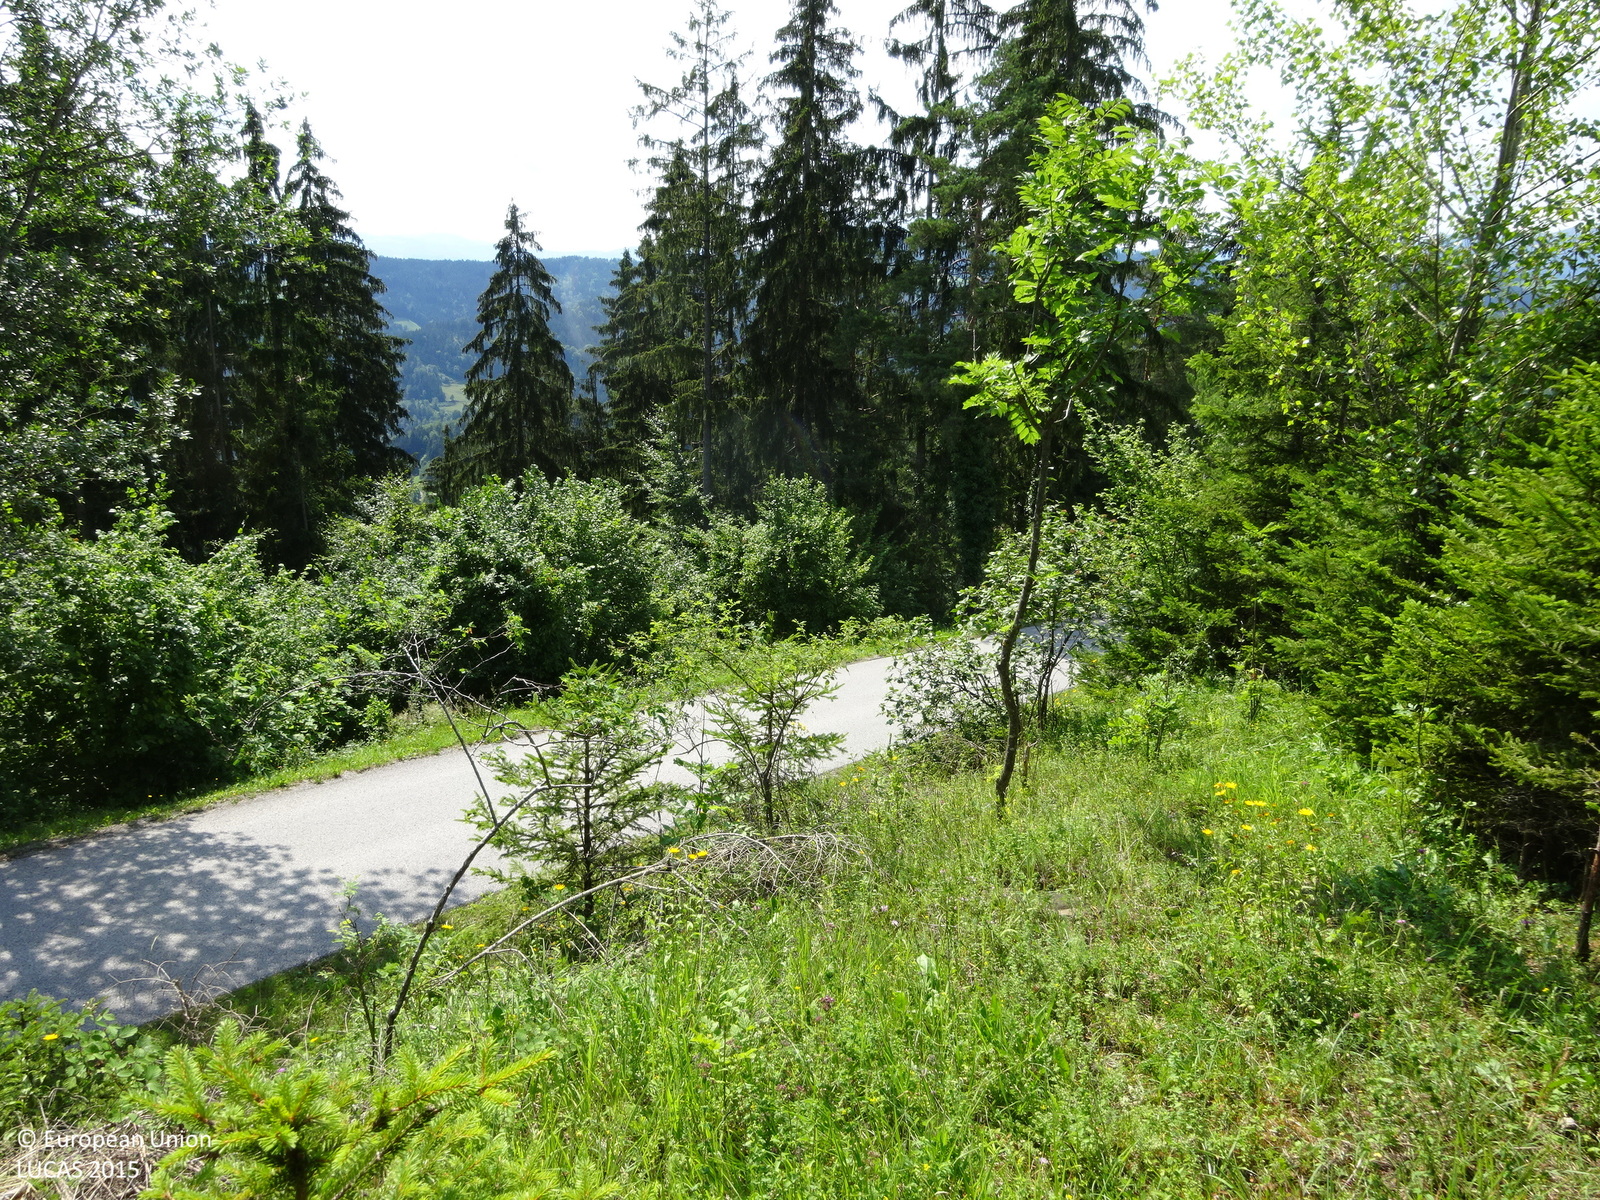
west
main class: Woodland
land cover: Spruce dominated coniferous woodland
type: alpine coniferous forest
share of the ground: 50 - 75 %
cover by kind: coniferous forest trees 70 %, shrubs 25 %, broadleaved forest trees 5 %
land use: Forestry
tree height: < 5 m
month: July
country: AT
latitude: 47.1279
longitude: 15.1802
